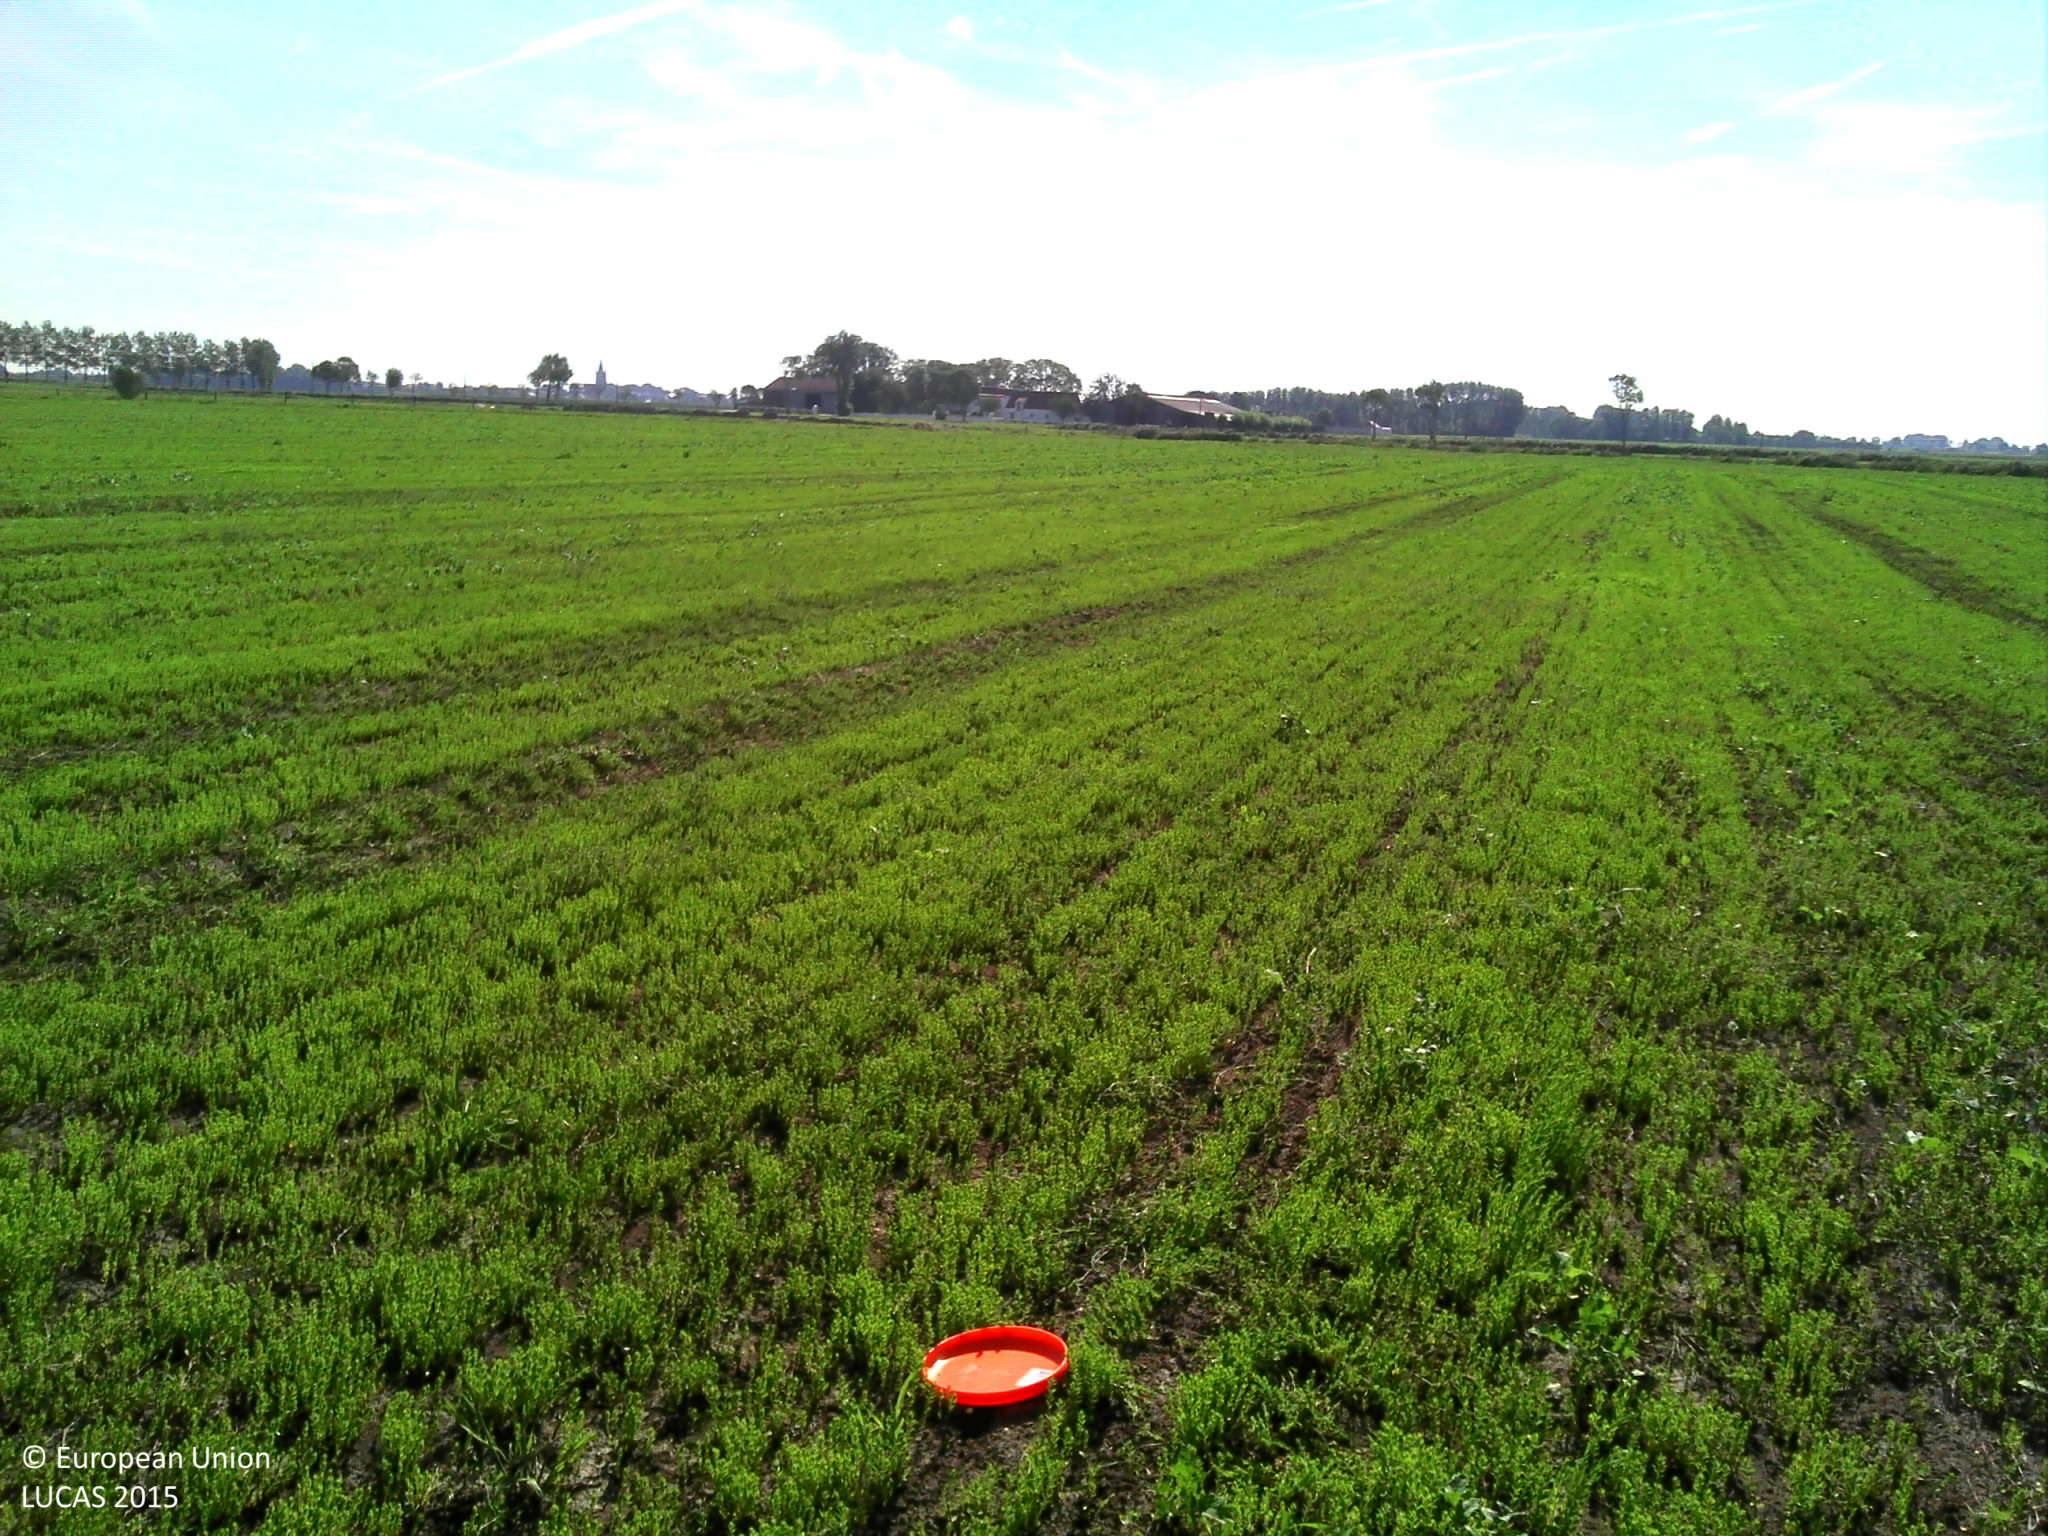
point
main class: Cropland
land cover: Other fibre and oleaginous crops
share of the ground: 50 - 75 %
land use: Agriculture (excluding fallow land and kitchen gardens)
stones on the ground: < 10 %
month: September
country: BE
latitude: 51.1872
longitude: 2.8497
